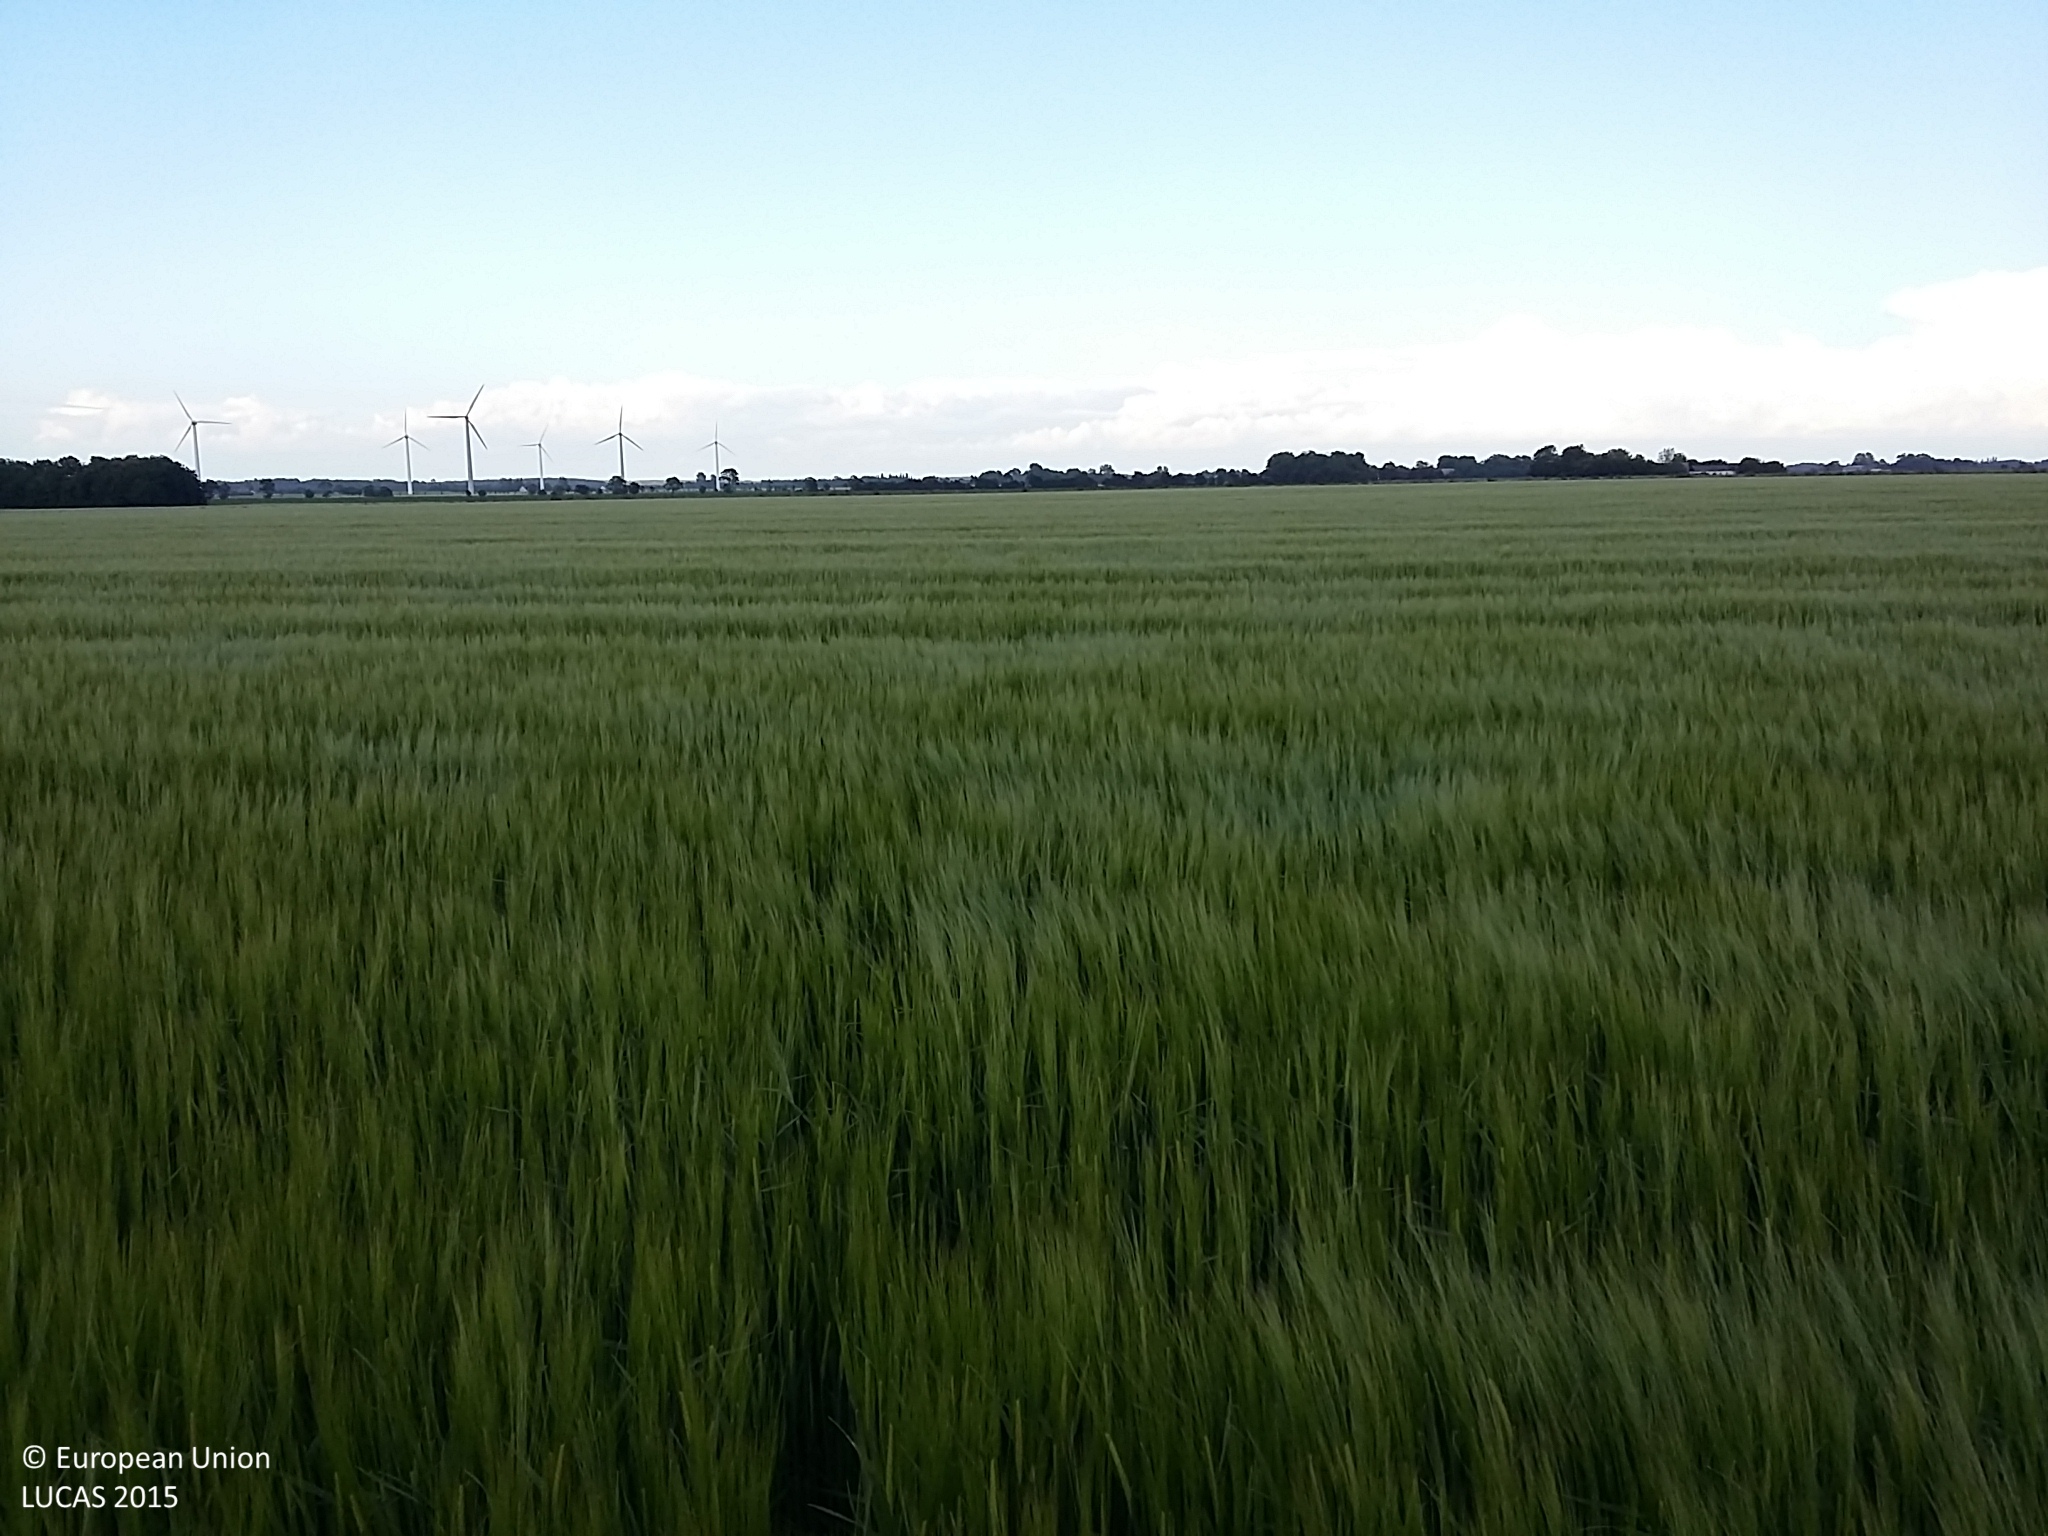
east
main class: Cropland
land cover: Barley
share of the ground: > 75 %
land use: Agriculture (excluding fallow land and kitchen gardens)
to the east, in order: Barley
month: June
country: DK
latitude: 54.7797
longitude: 11.2274
